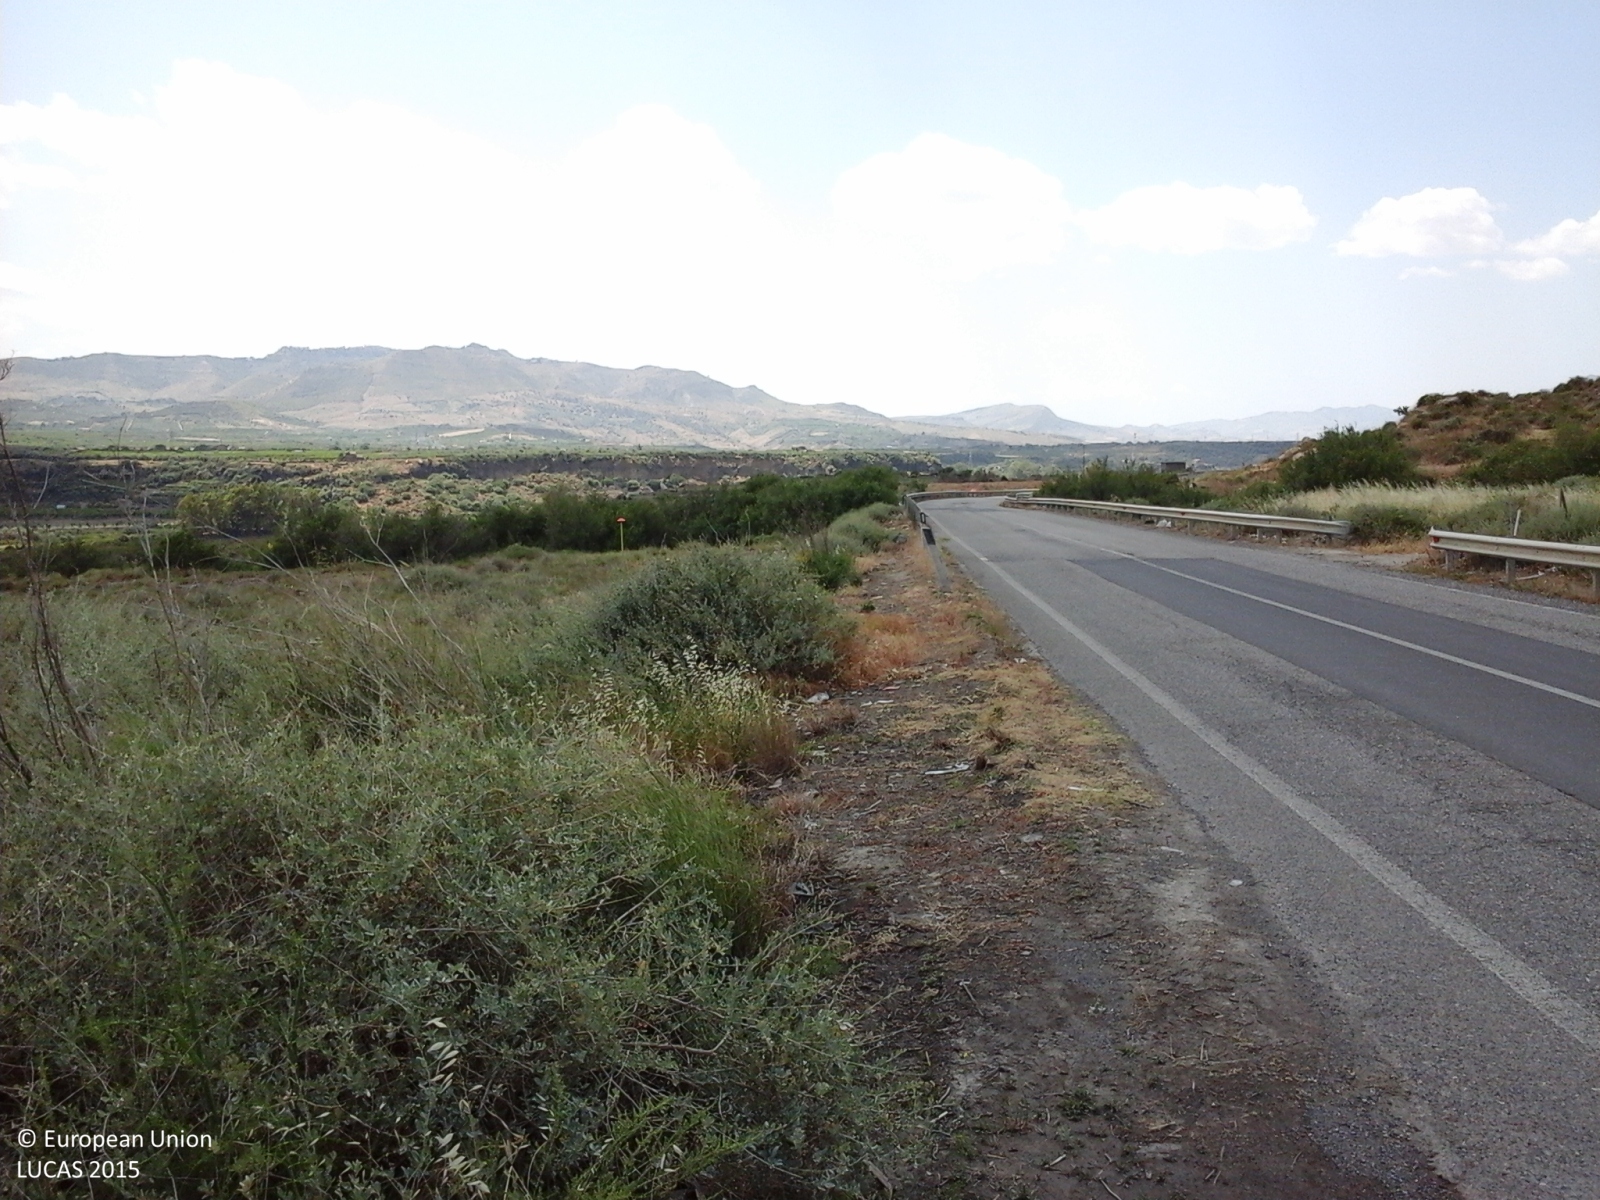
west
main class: Grassland
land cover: Grassland without tree/shrub cover
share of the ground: > 75 %
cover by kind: herbaceous plants 100 %
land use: Agriculture (excluding fallow land and kitchen gardens)
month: May
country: IT
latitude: 37.6431
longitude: 14.8277
